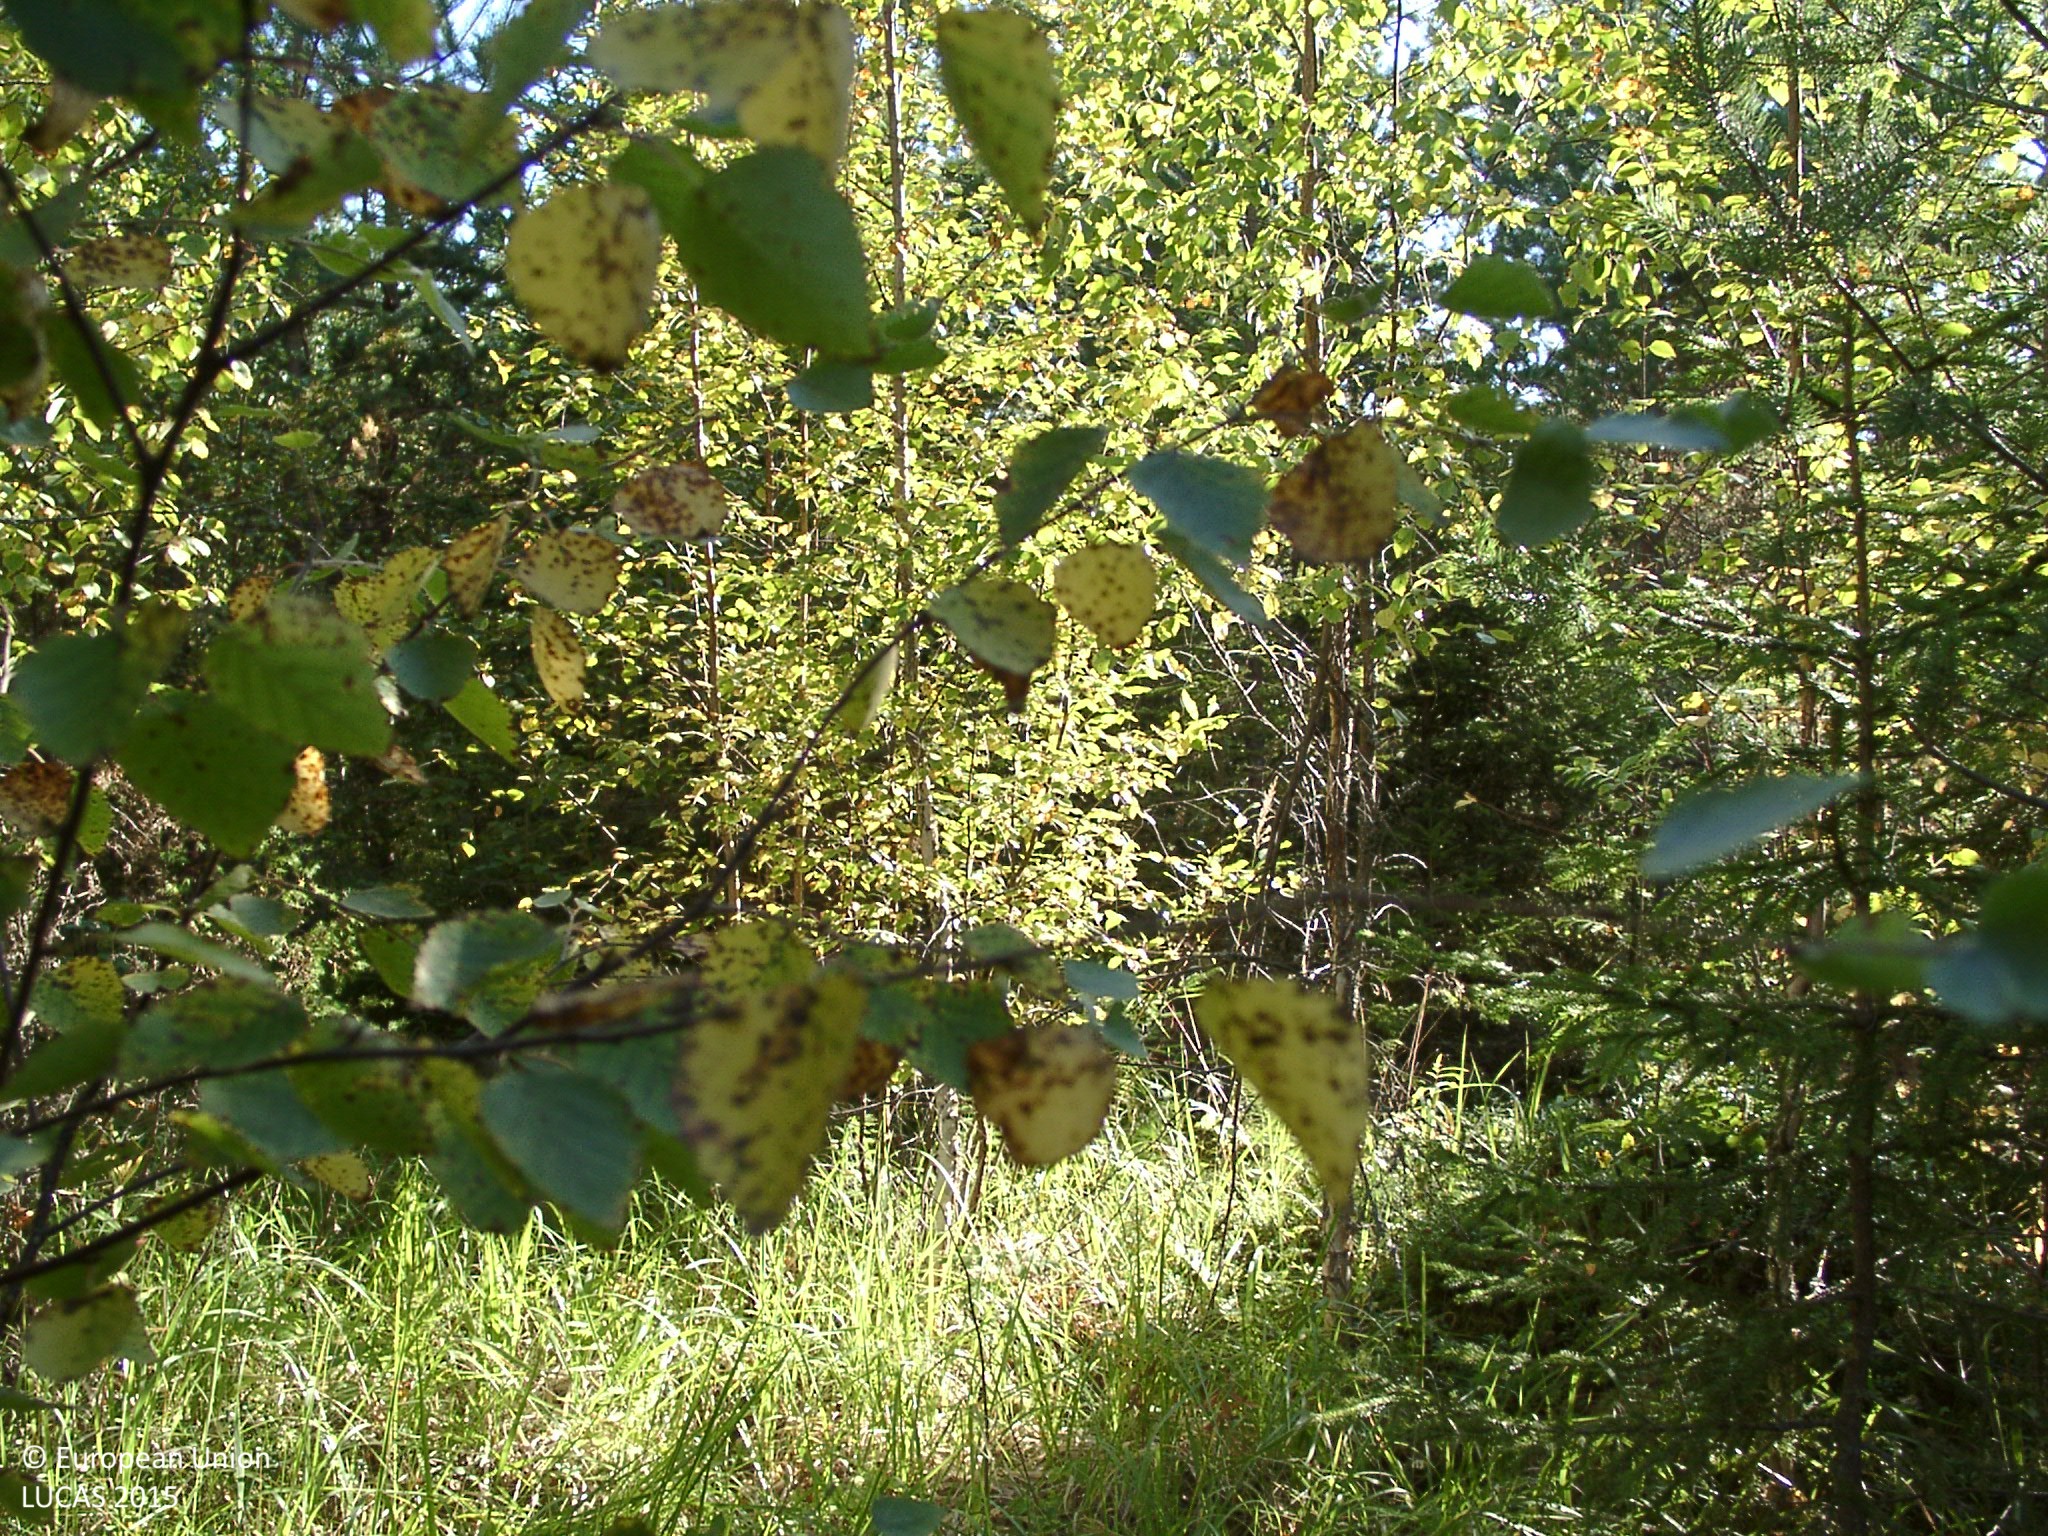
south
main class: Woodland
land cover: Pine dominated mixed woodland
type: boreal forest
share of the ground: 50 - 75 %
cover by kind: coniferous forest trees 50 %, broadleaved forest trees 20 %, shrubs 15 %, herbaceous plants 10 %, lichens and mosses 5 %
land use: Forestry
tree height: < 5 m
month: August
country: FI
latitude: 62.0053
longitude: 24.7859
